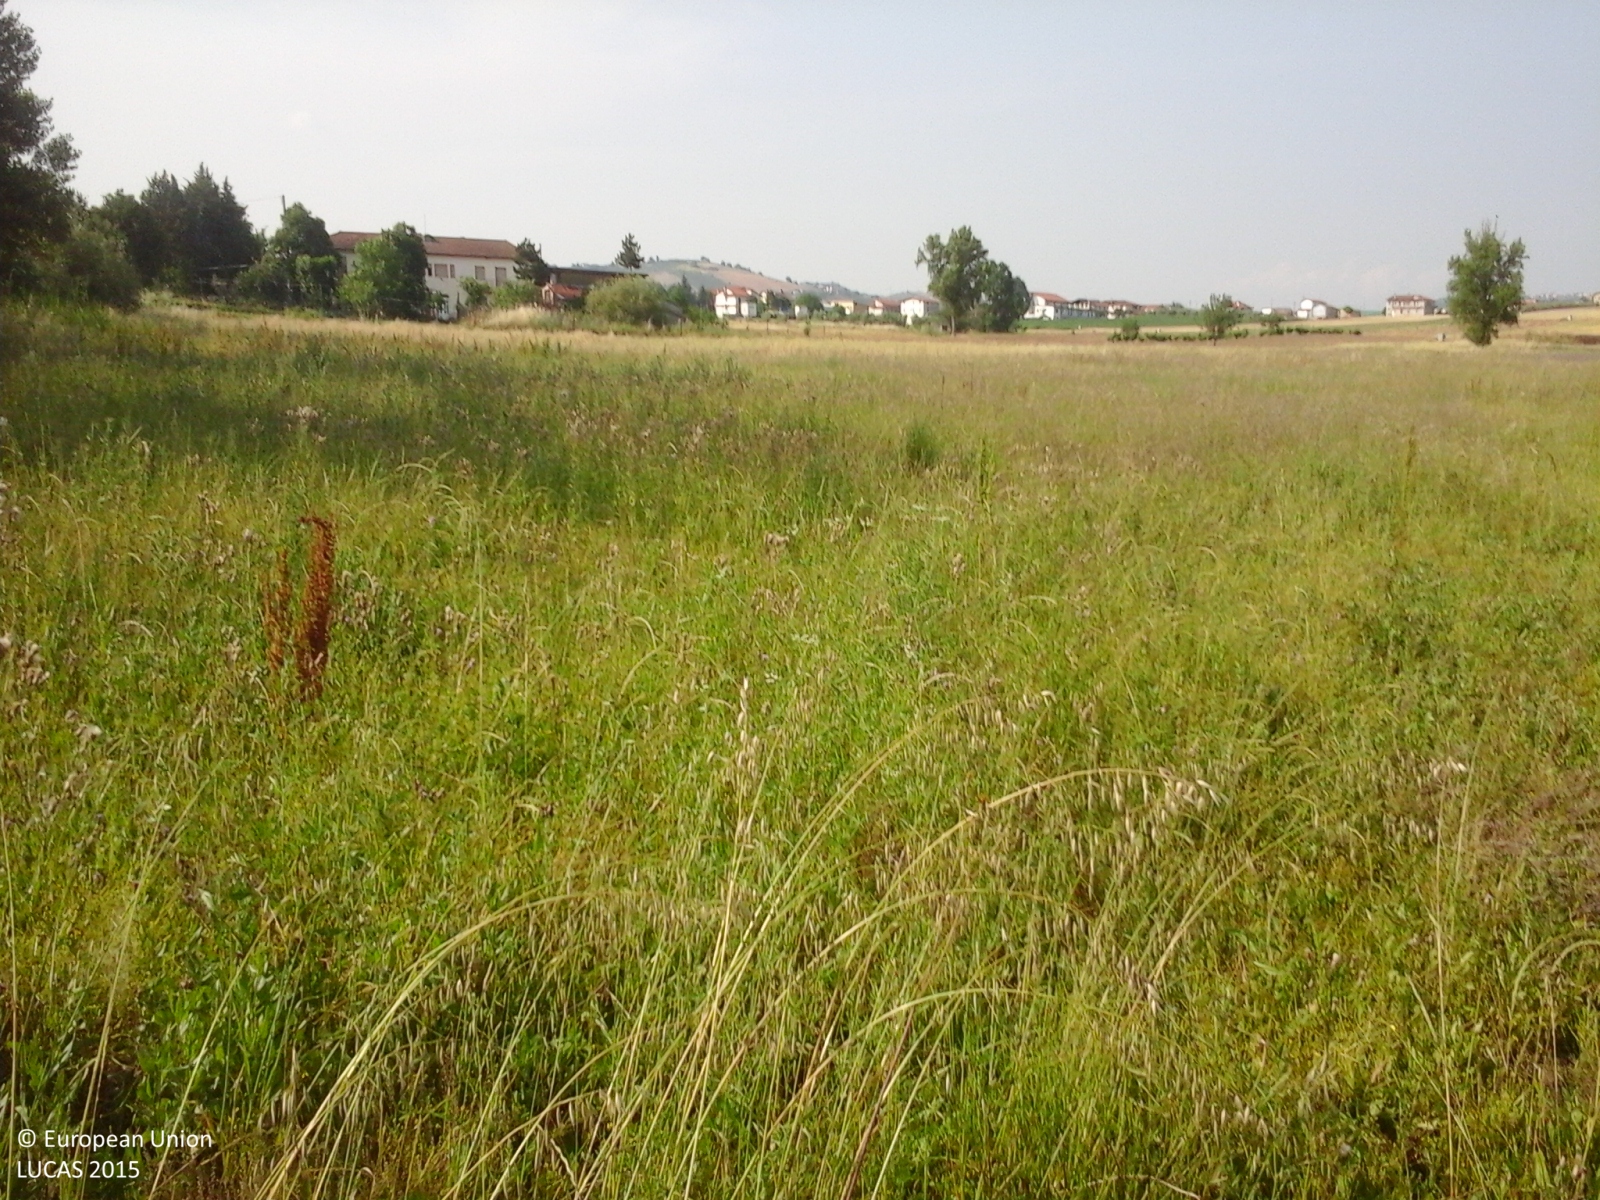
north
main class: Grassland
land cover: Spontaneously vegetated surfaces
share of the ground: > 75 %
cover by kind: herbaceous plants 100 %
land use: Fallow land
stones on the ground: < 10 %
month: June
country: IT
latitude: 41.0766
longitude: 15.1108
